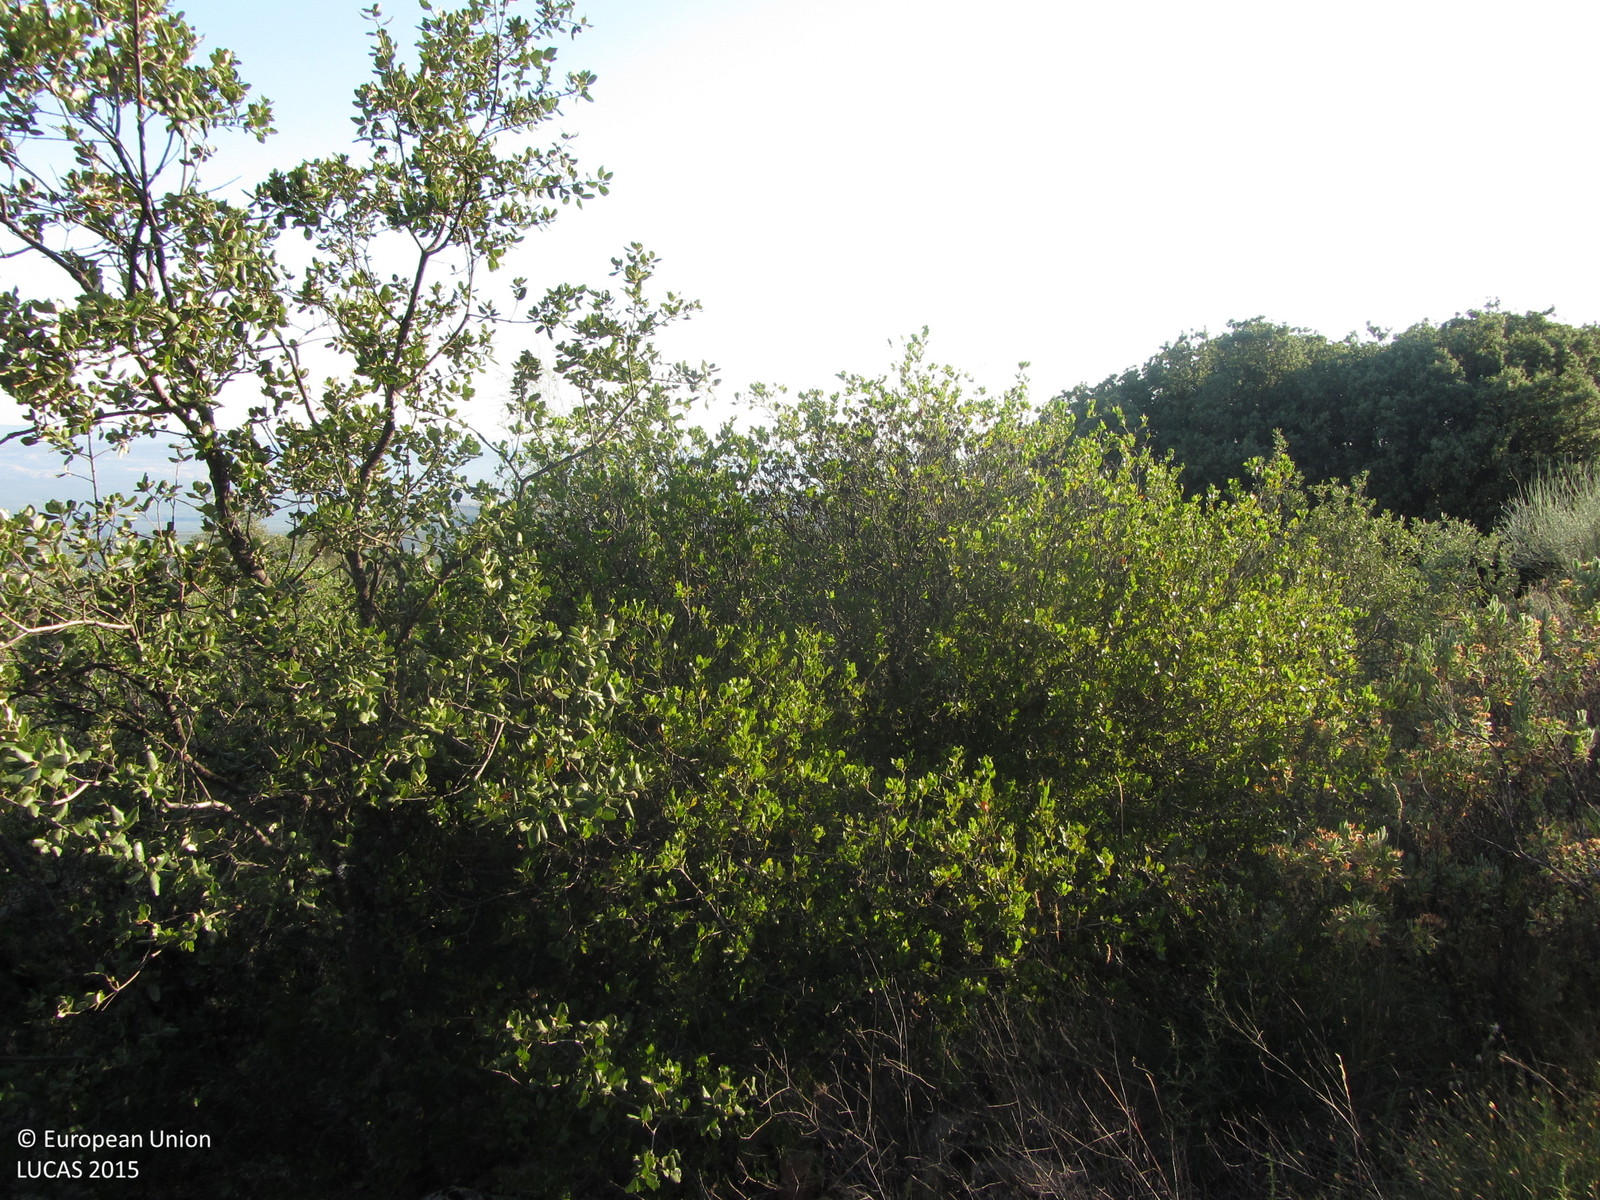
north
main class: Woodland
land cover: Broadleaved woodland
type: broadleaved evergreen forest
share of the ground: 50 - 75 %
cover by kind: broadleaved forest trees 50 %, herbaceous plants 25 %, lichens and mosses 25 %
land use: Semi-natural and natural areas not in use
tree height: > 5 m
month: June
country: ES
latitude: 38.1953
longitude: -2.9586
